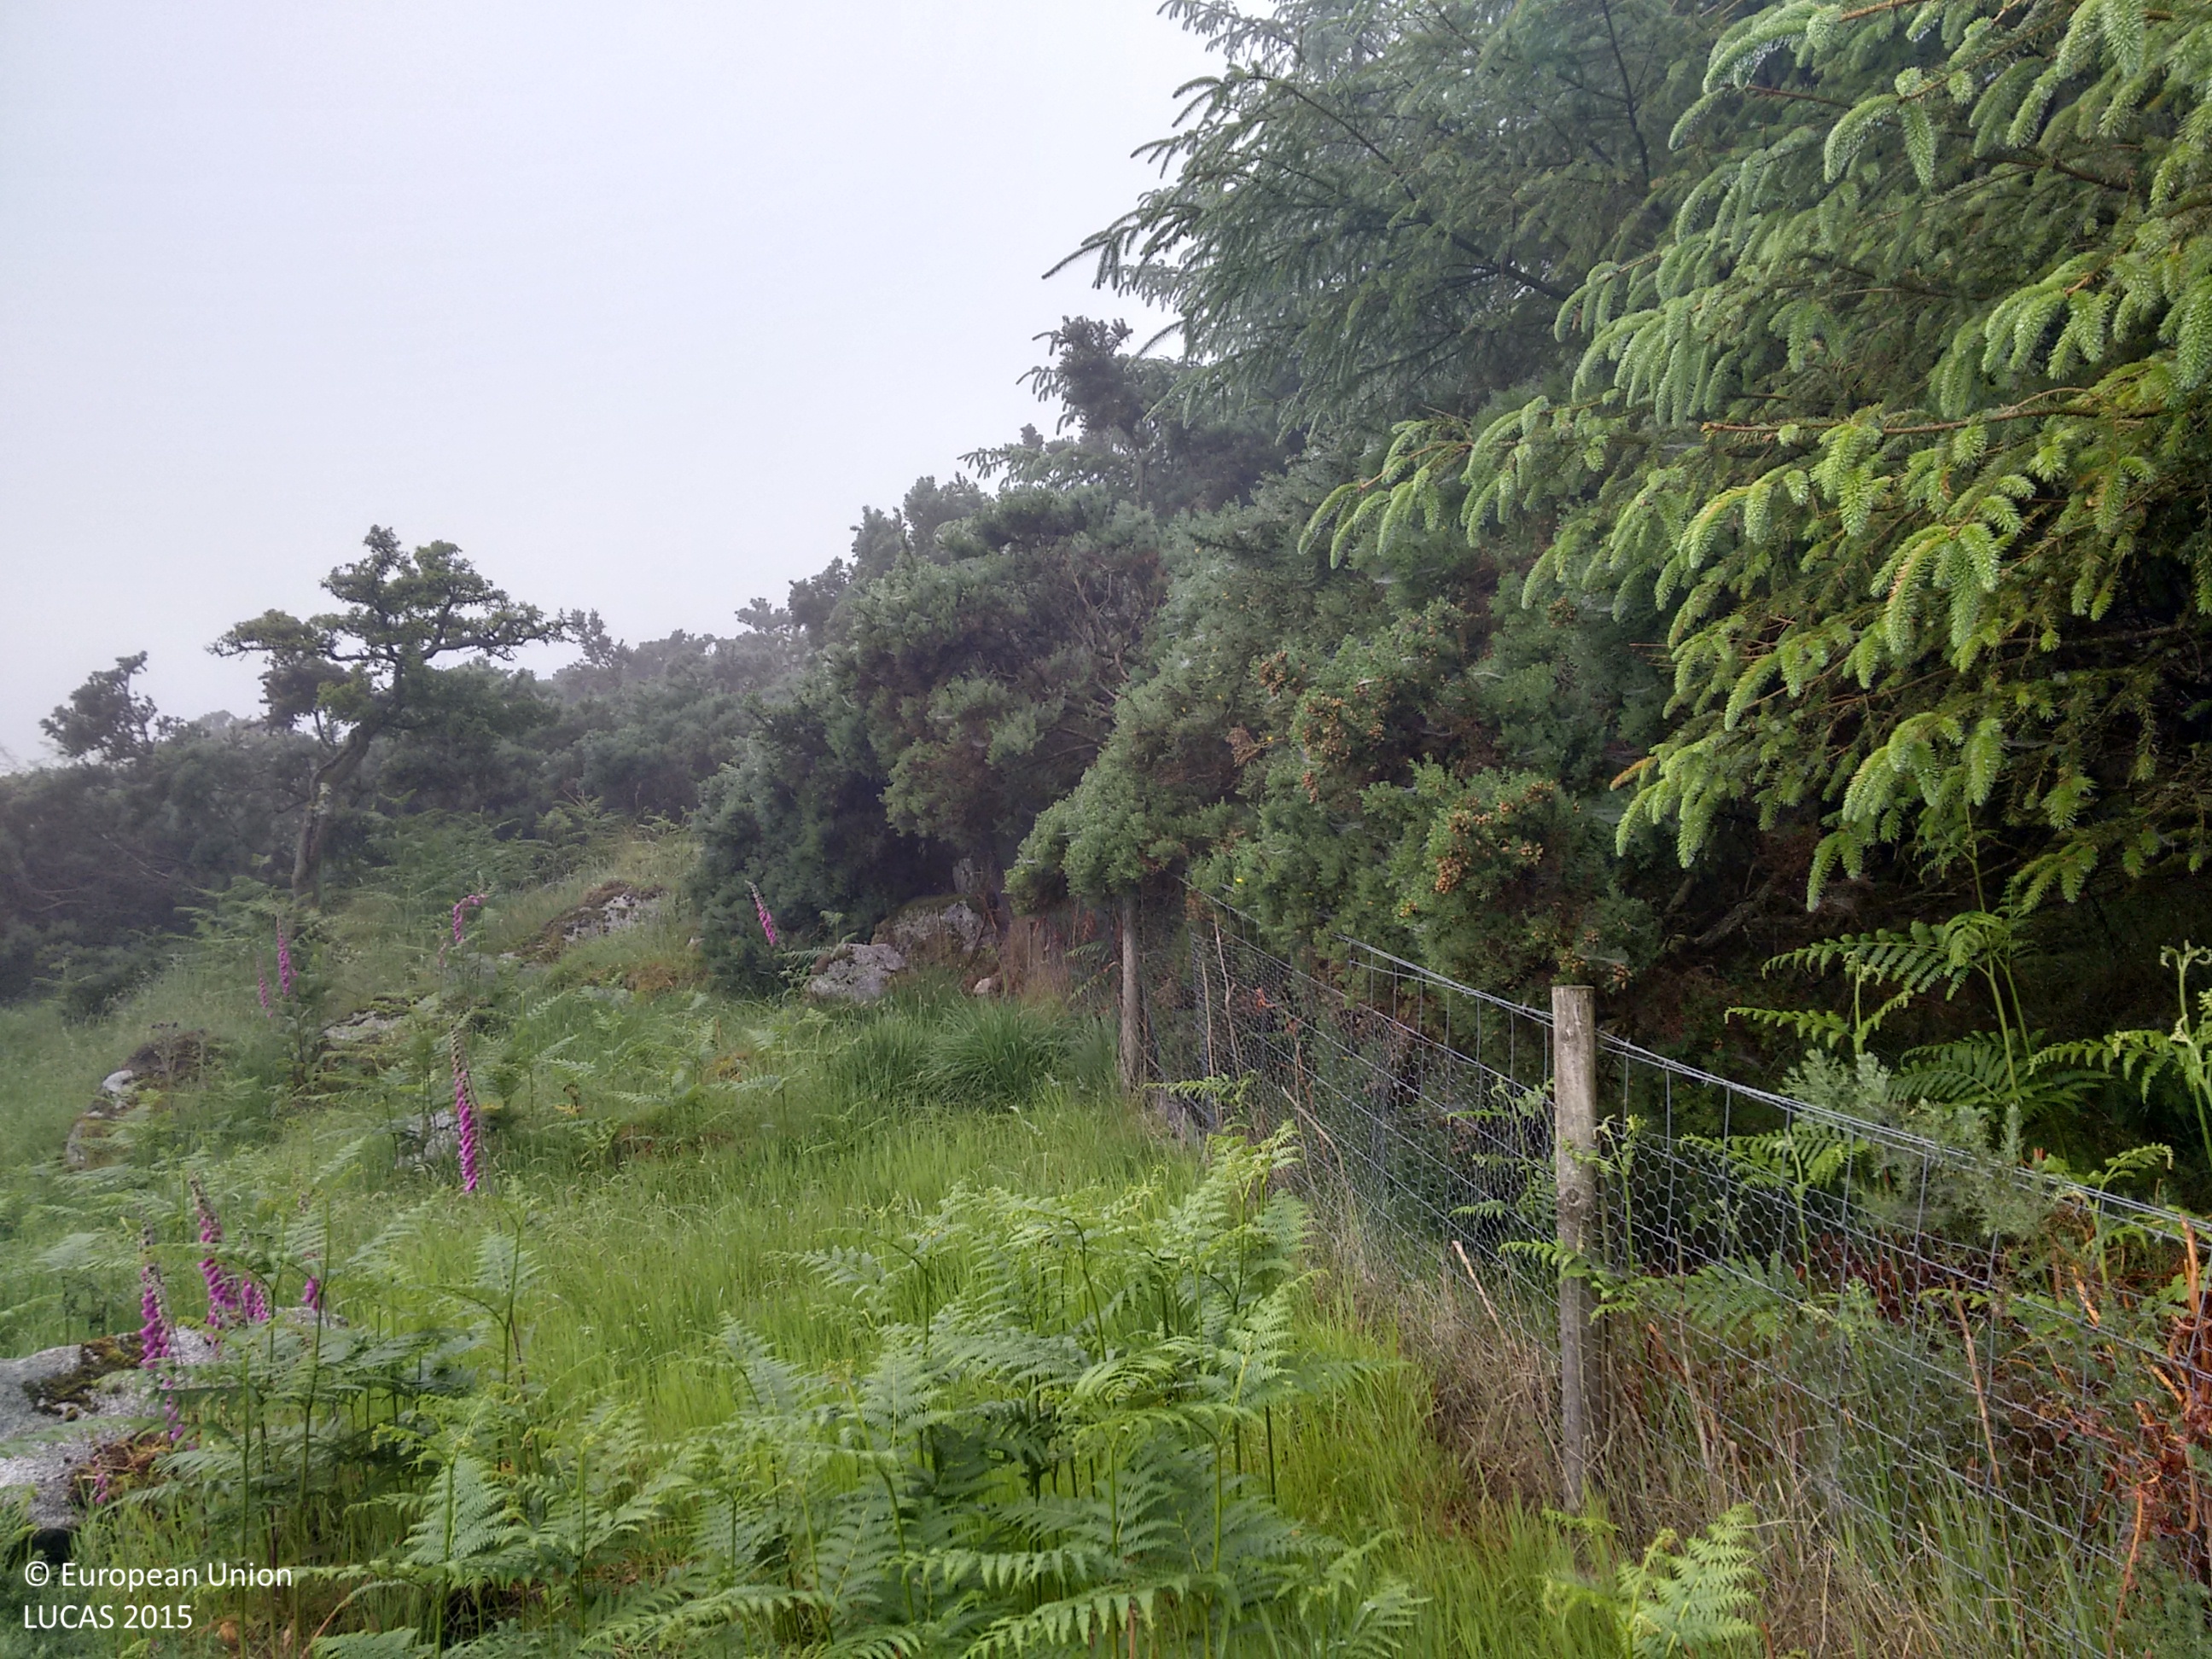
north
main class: Woodland
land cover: Spruce dominated coniferous woodland
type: exotic forest
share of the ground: > 75 %
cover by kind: coniferous forest trees 100 %
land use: Forestry
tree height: > 5 m
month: July
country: GB
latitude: 54.9214
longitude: -3.6740
